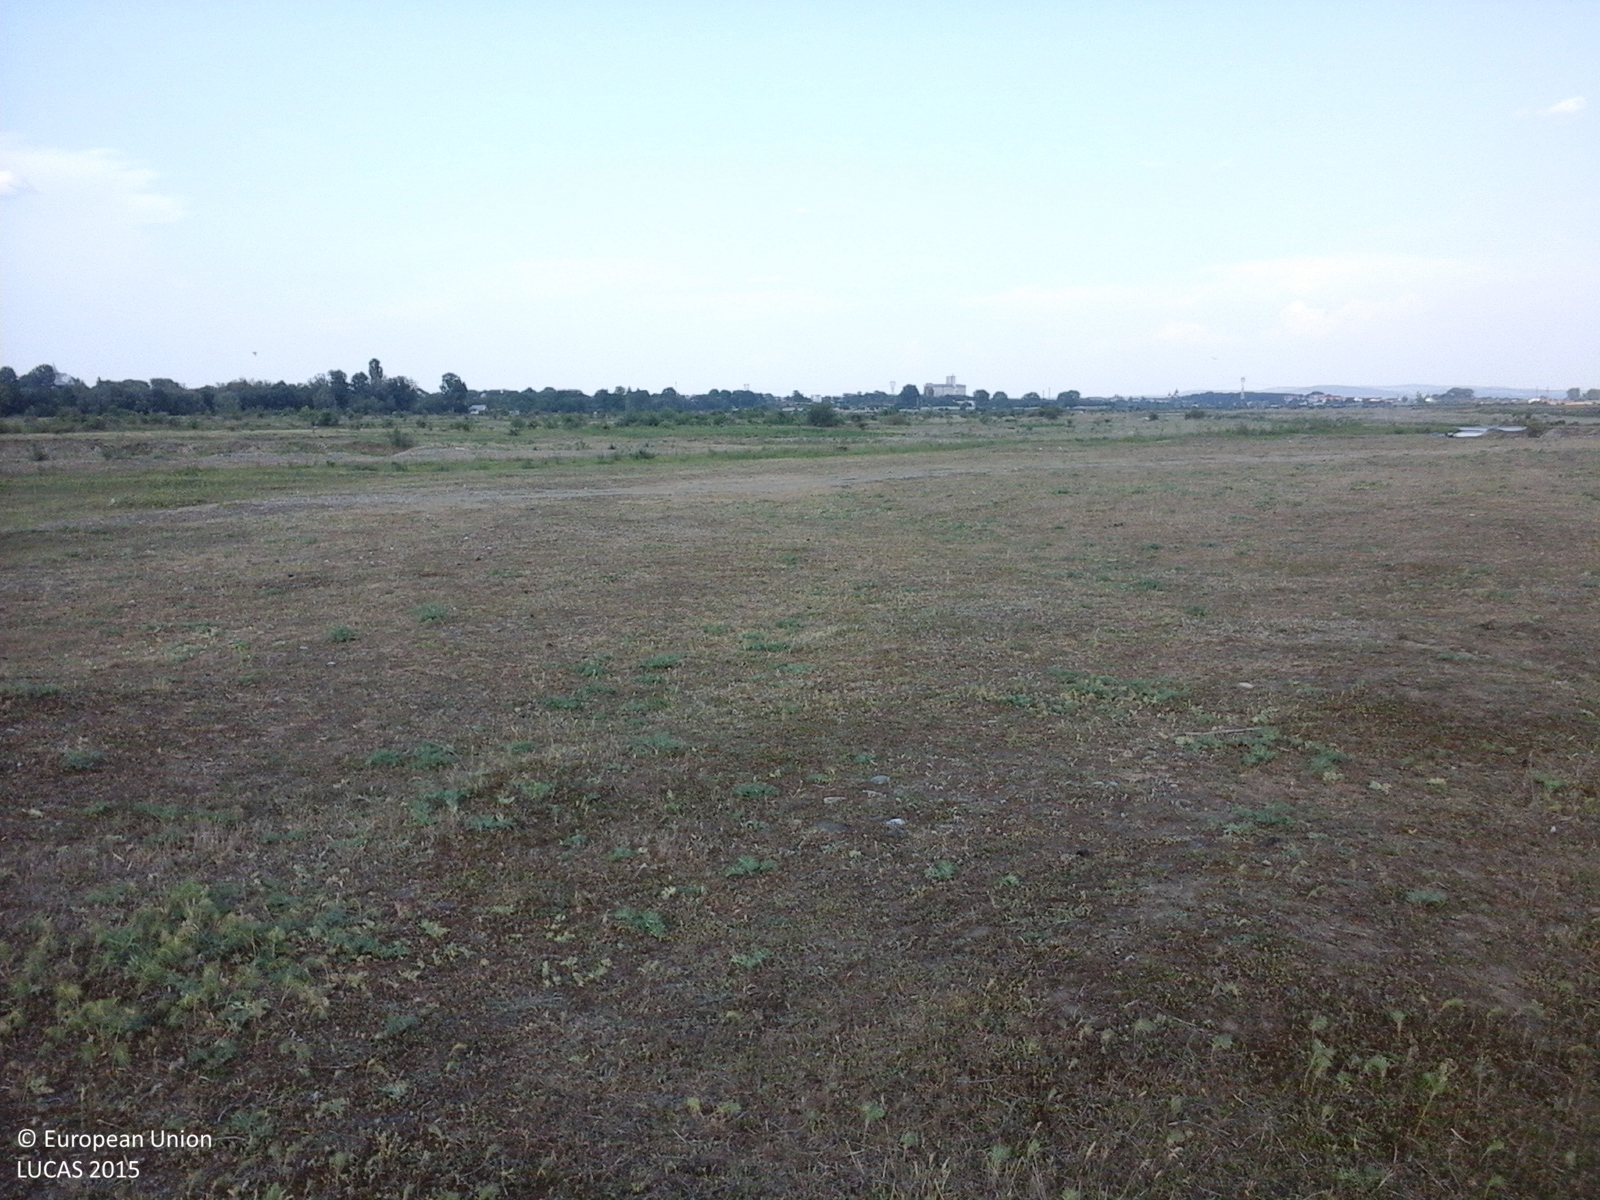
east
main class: Grassland
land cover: Grassland without tree/shrub cover
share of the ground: 50 - 75 %
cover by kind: herbaceous plants 100 %
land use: Agriculture (excluding fallow land and kitchen gardens)
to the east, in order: Grassland without tree/shrub cover; Tracks; Grassland without tree/shrub cover; Rocks and stones; Inland fresh running water; Grassland without tree/shrub cover
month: June
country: RO
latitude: 46.8460
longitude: 26.4623
